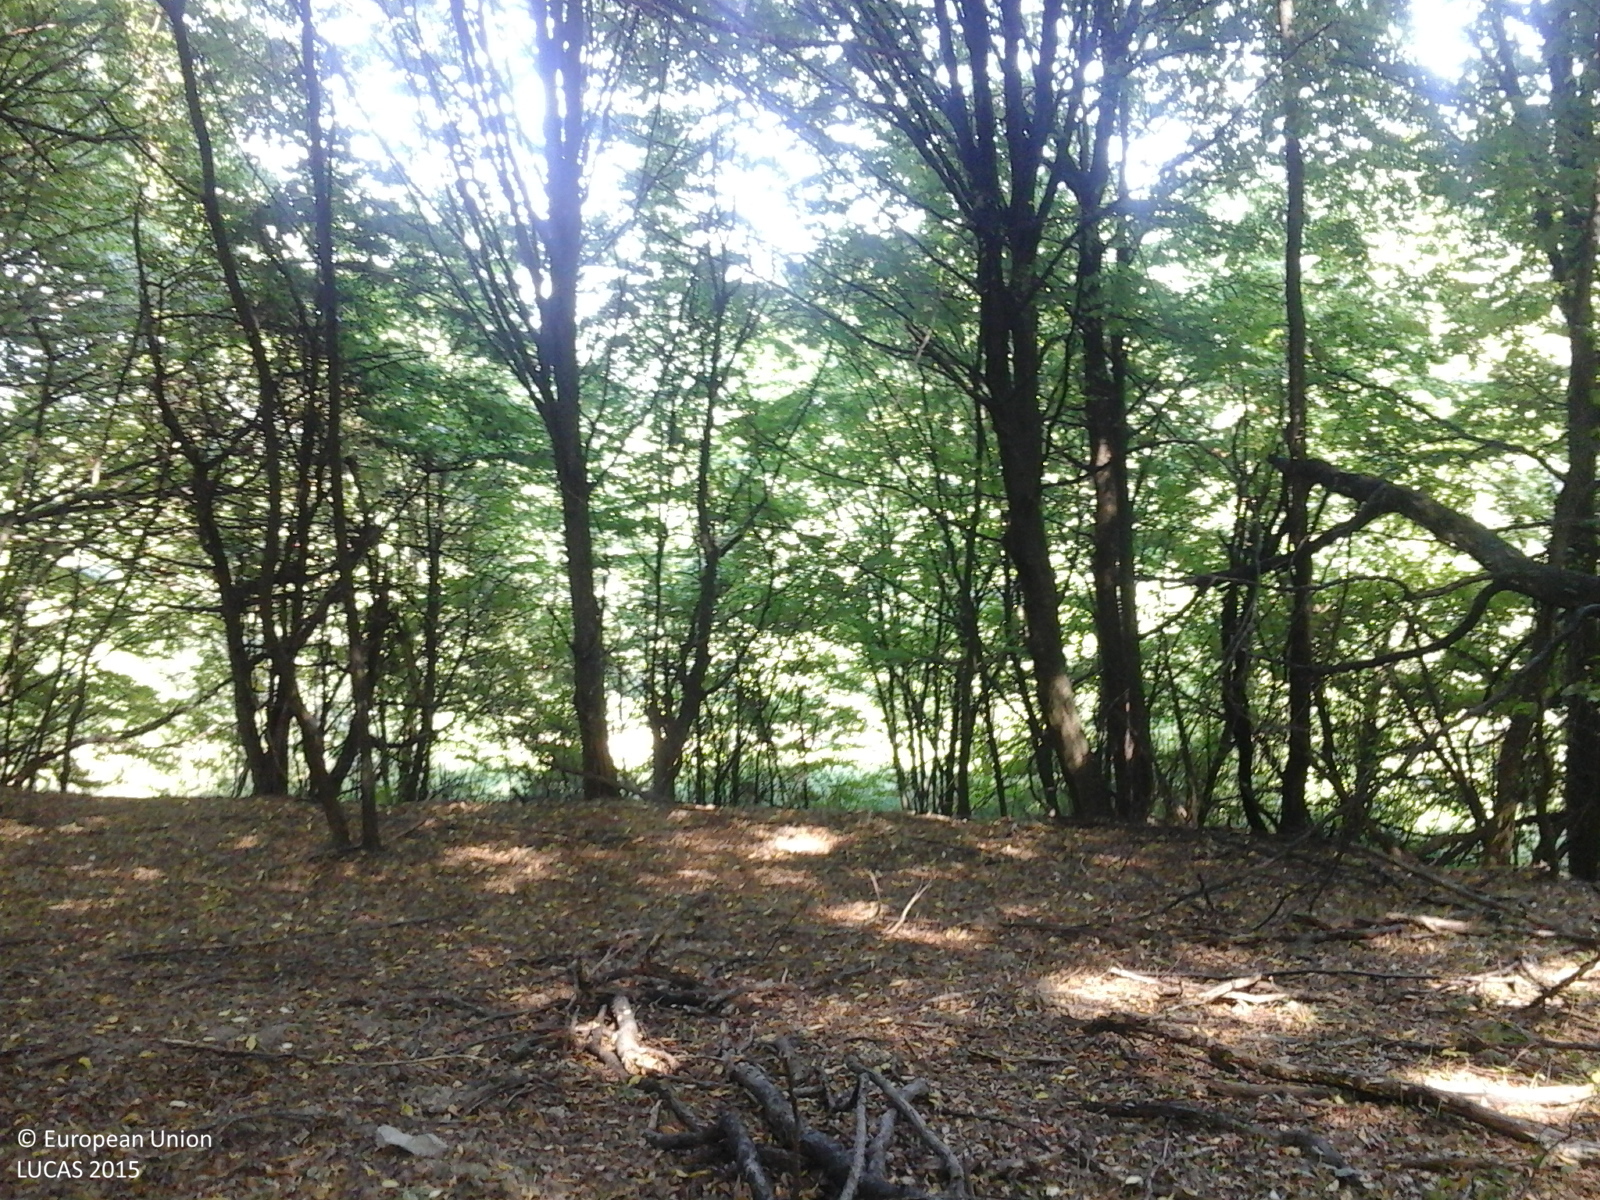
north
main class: Woodland
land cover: Broadleaved woodland
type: beech forest
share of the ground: > 75 %
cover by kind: broadleaved forest trees 100 %
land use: Forestry
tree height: > 5 m
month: August
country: RO
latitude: 45.9010
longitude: 22.6954
